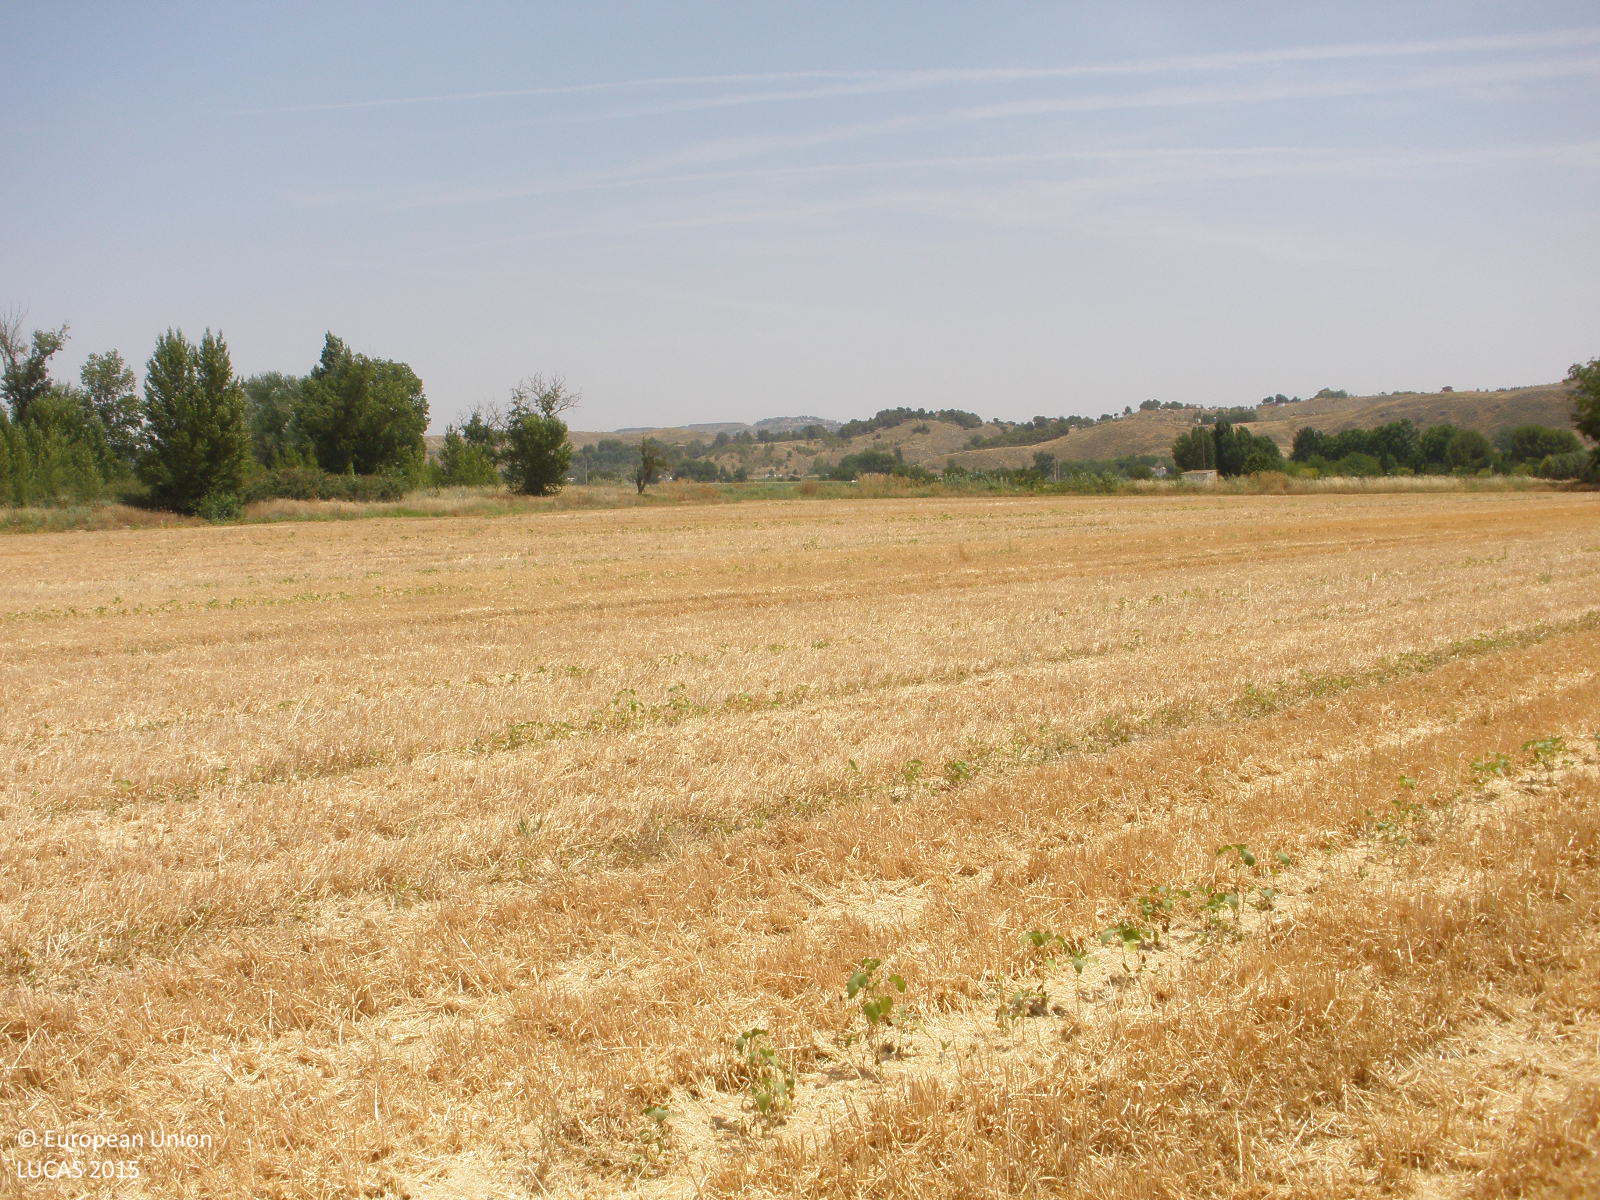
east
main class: Cropland
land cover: Barley
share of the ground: < 10 %
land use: Agriculture (excluding fallow land and kitchen gardens)
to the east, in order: Barley; Shrubland with sparse tree cover; Grassland without tree/shrub cover; Single bushes/trees
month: July
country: ES
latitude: 40.1509
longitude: -3.5200
